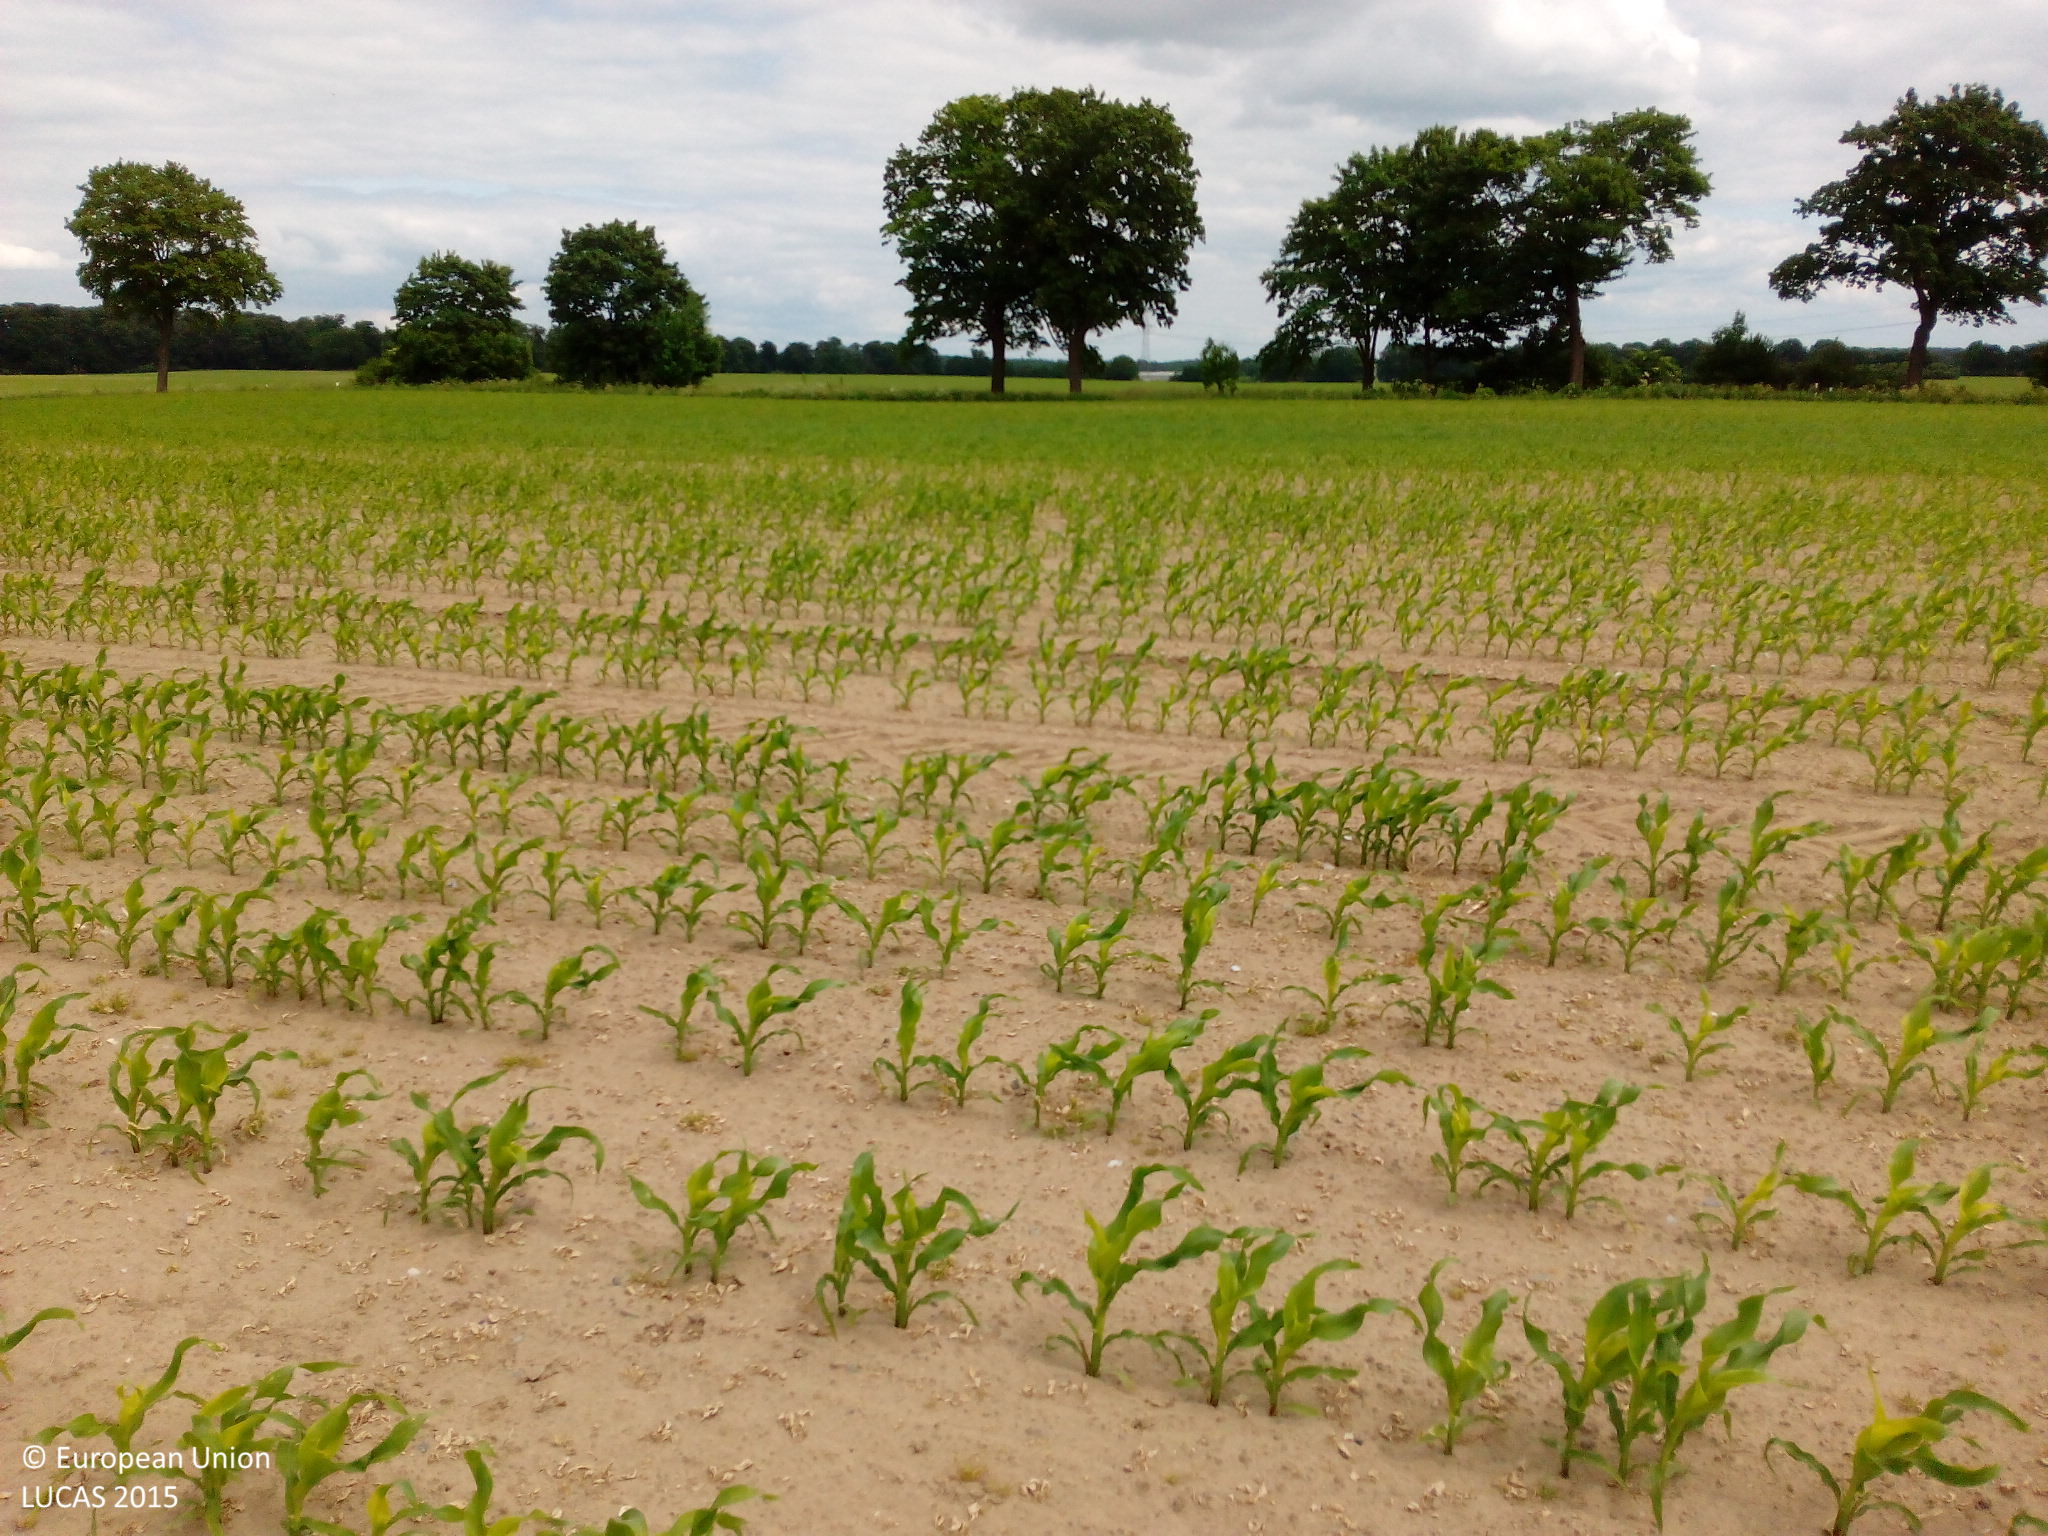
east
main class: Cropland
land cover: Maize
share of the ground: < 10 %
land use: Agriculture (excluding fallow land and kitchen gardens)
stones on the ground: < 10 %
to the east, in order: Maize; Shruby margins; Ditches and canals; Lines of trees; Paved roads, cycling and walking lanes; Lines of trees; Ditches and canals; Shruby margins; Maize
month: June
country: DE
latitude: 53.3610
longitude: 12.3585
